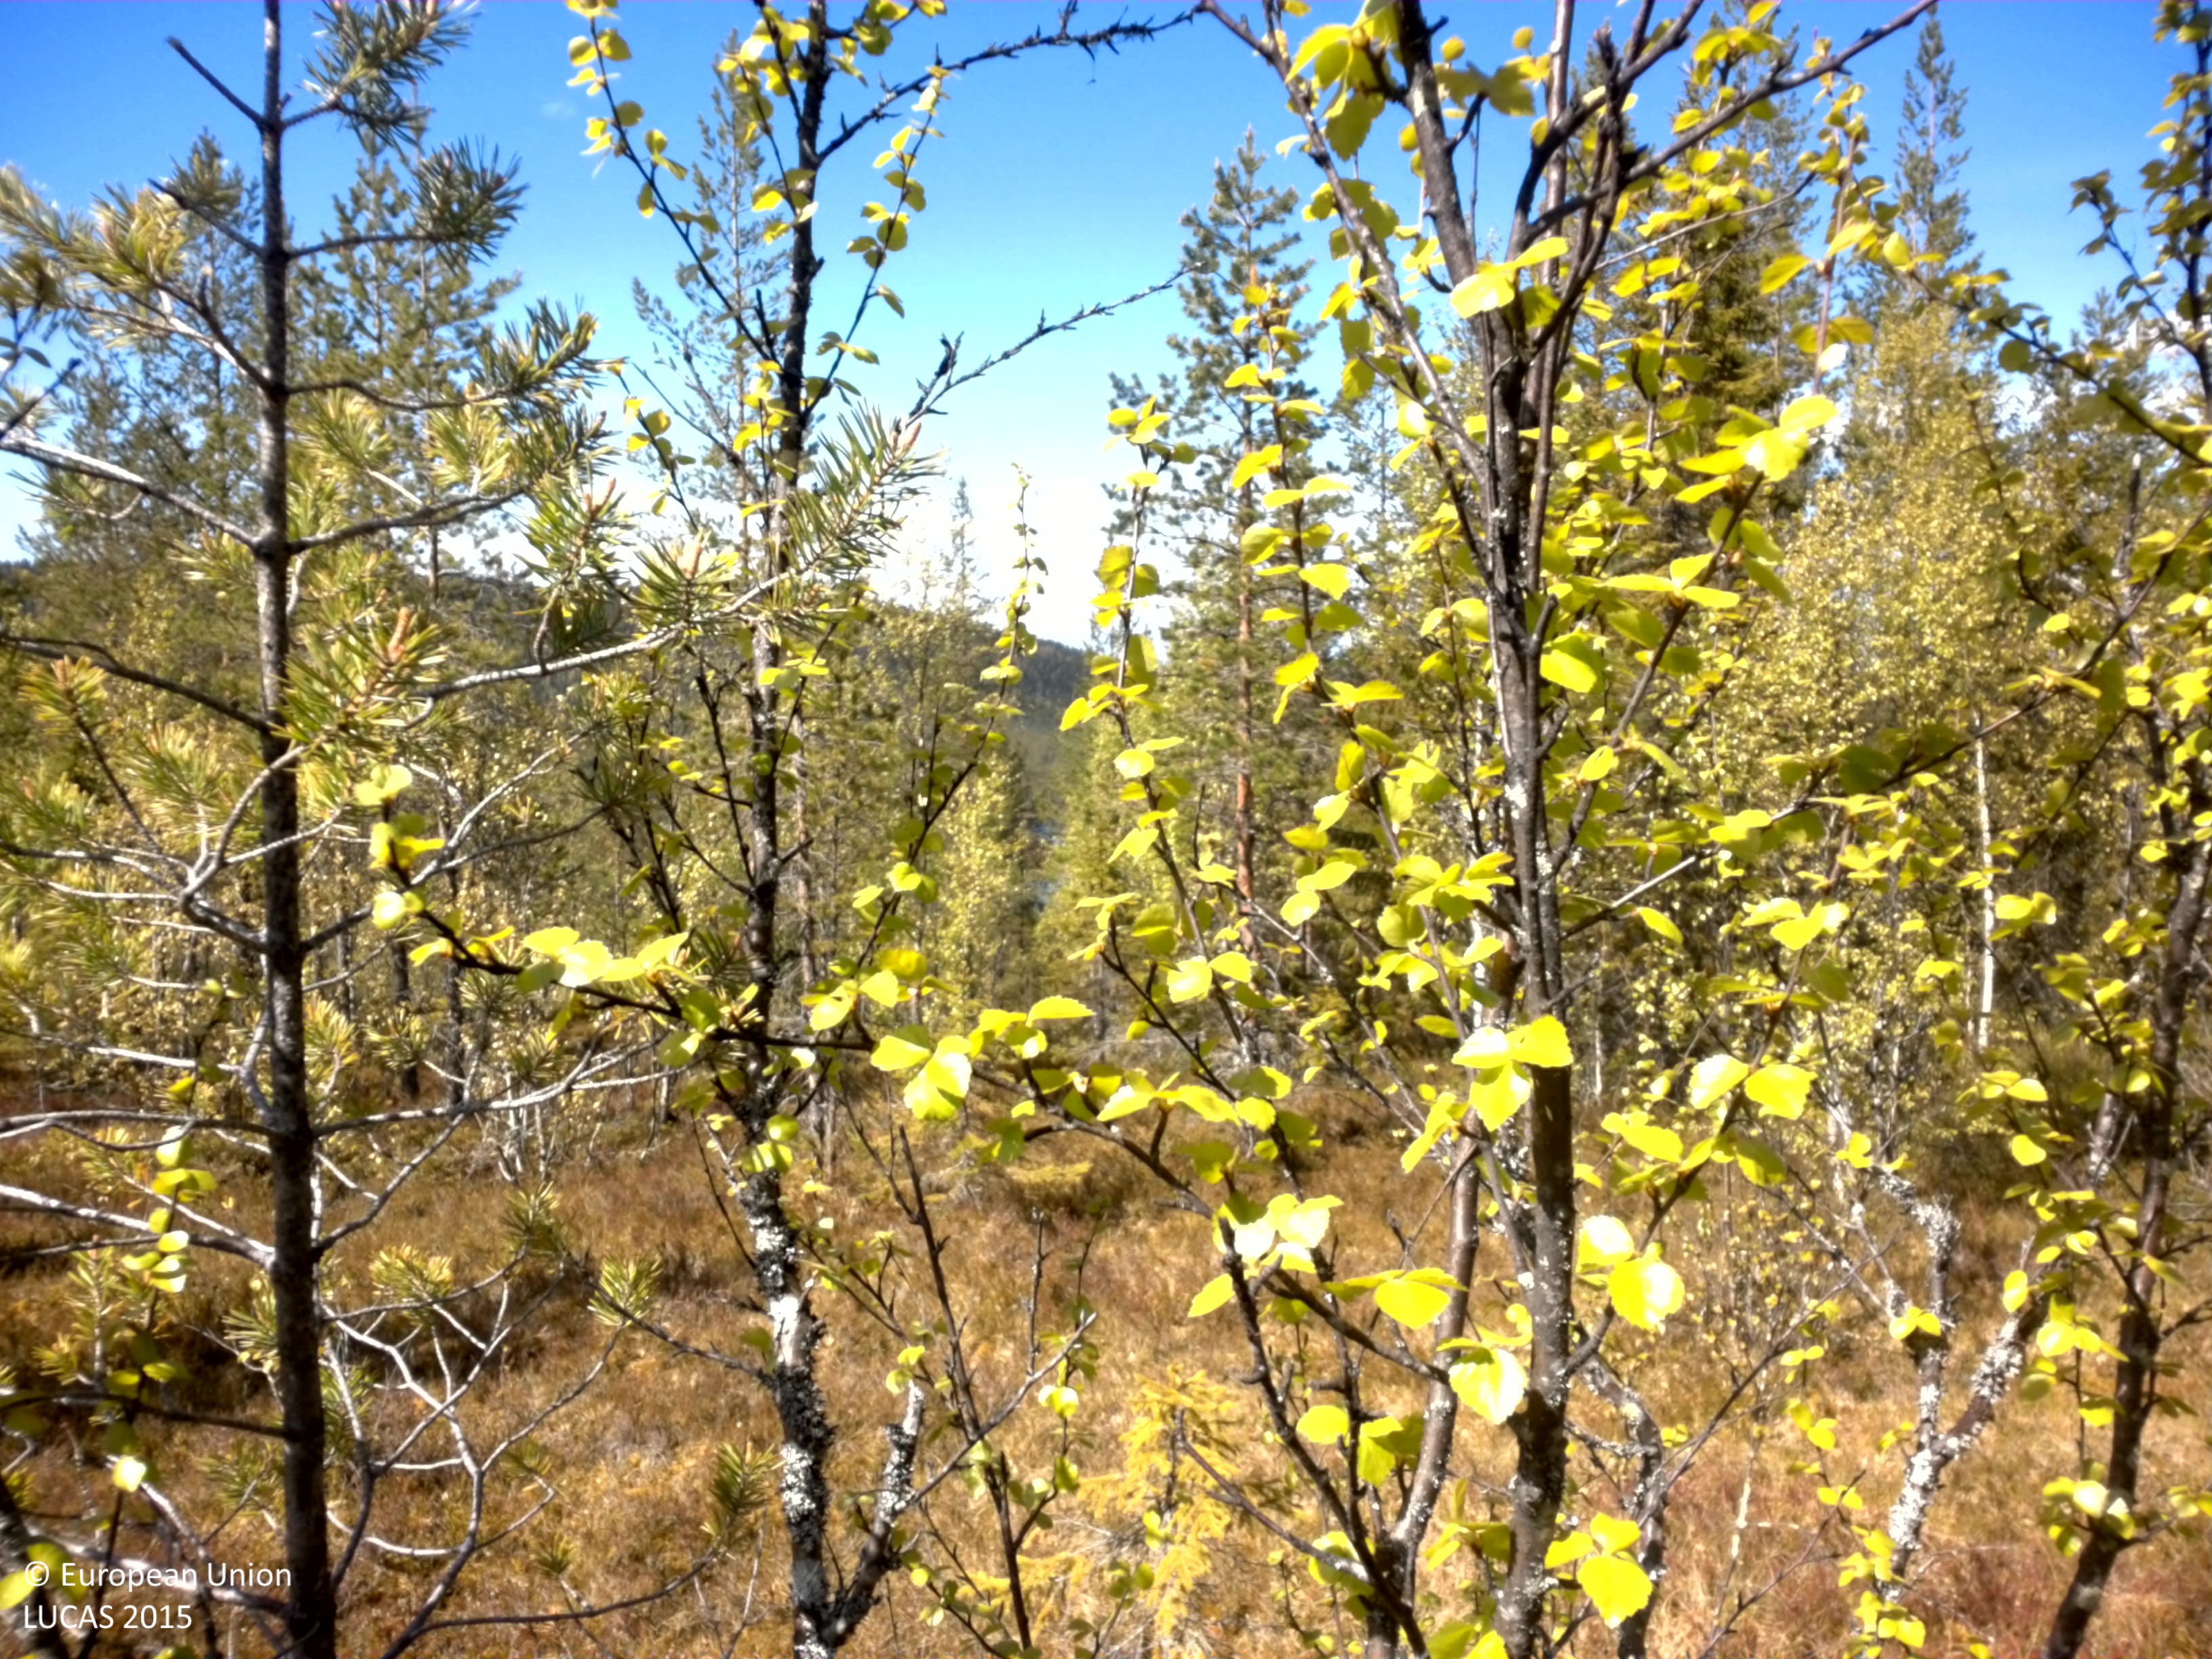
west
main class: Woodland
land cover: Pine dominated mixed woodland
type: boreal forest
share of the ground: 25 - 50 %
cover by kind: coniferous forest trees 30 %, herbaceous plants 20 %, broadleaved forest trees 15 %, lichens and mosses 15 %, shrubs 10 %, unconsolidated bare surface 10 %
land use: Forestry
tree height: > 5 m
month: June
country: SE
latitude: 64.3401
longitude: 17.2746
